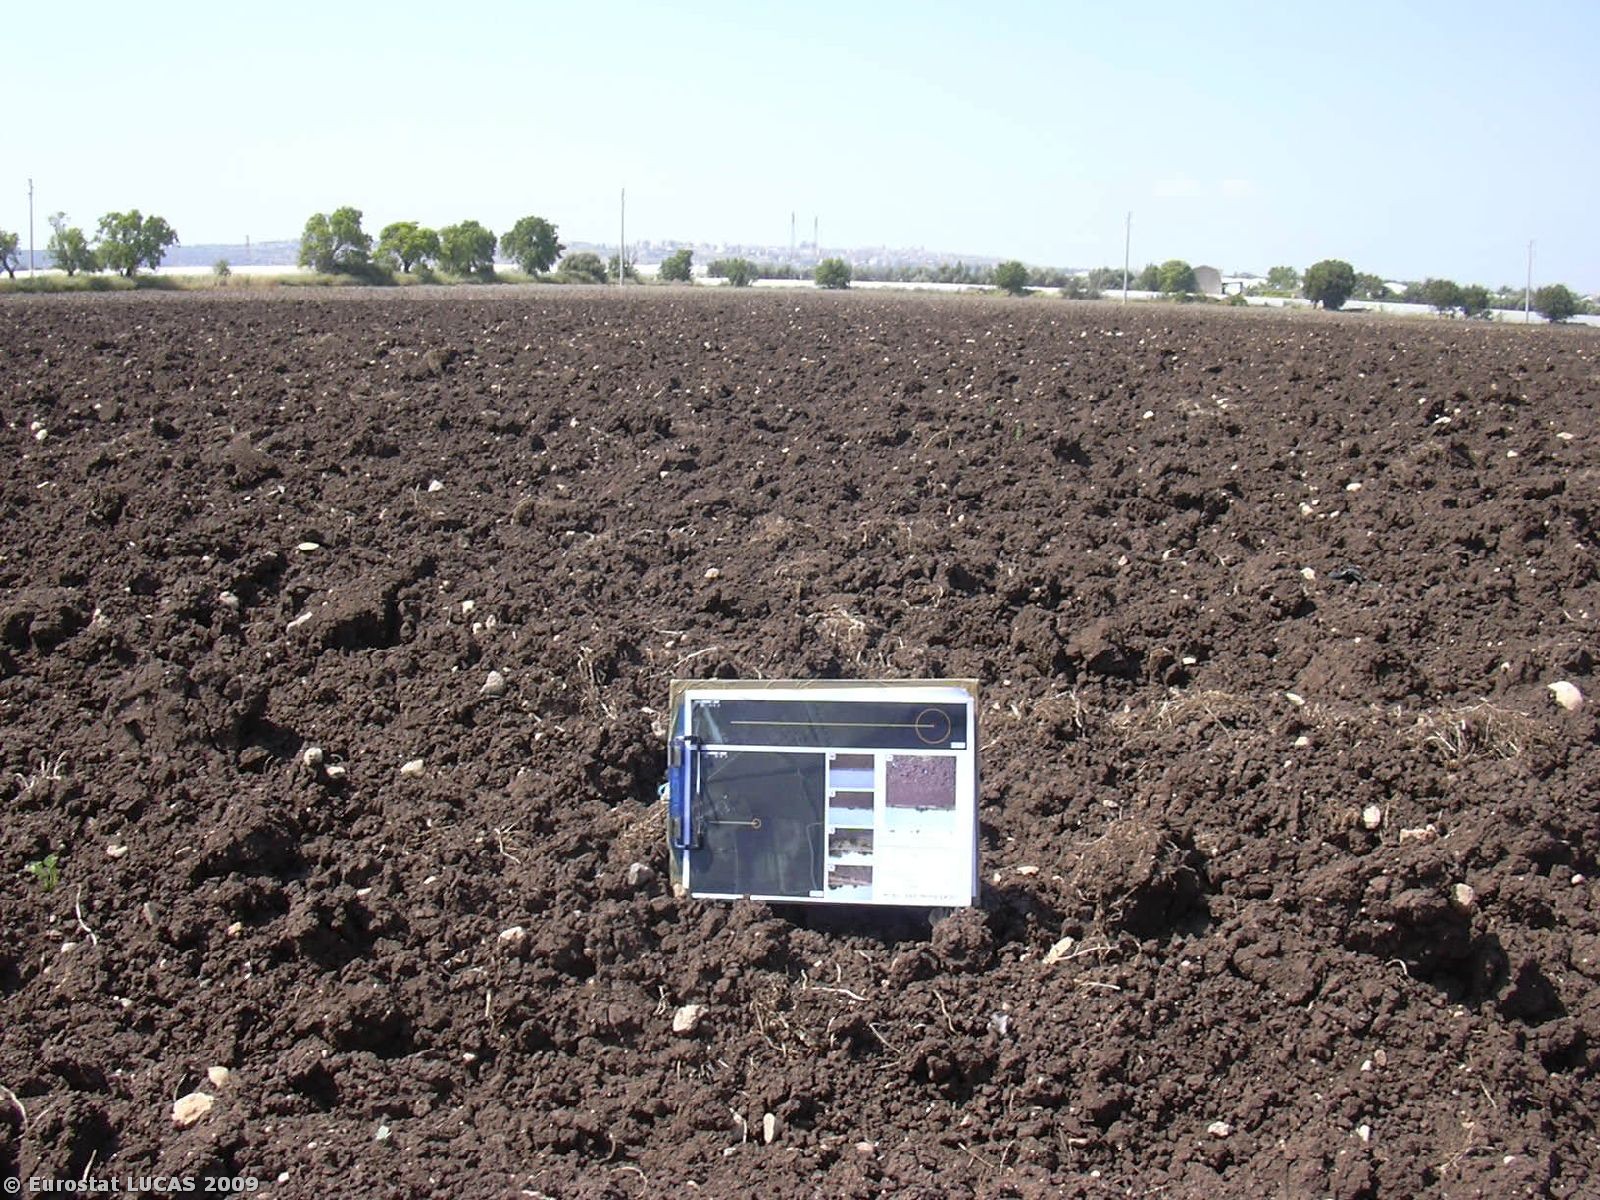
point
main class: Bare land
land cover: Bare land
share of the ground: < 10 %
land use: Agriculture (excluding fallow land and kitchen gardens)
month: May
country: IT
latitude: 36.7468
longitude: 14.9218
